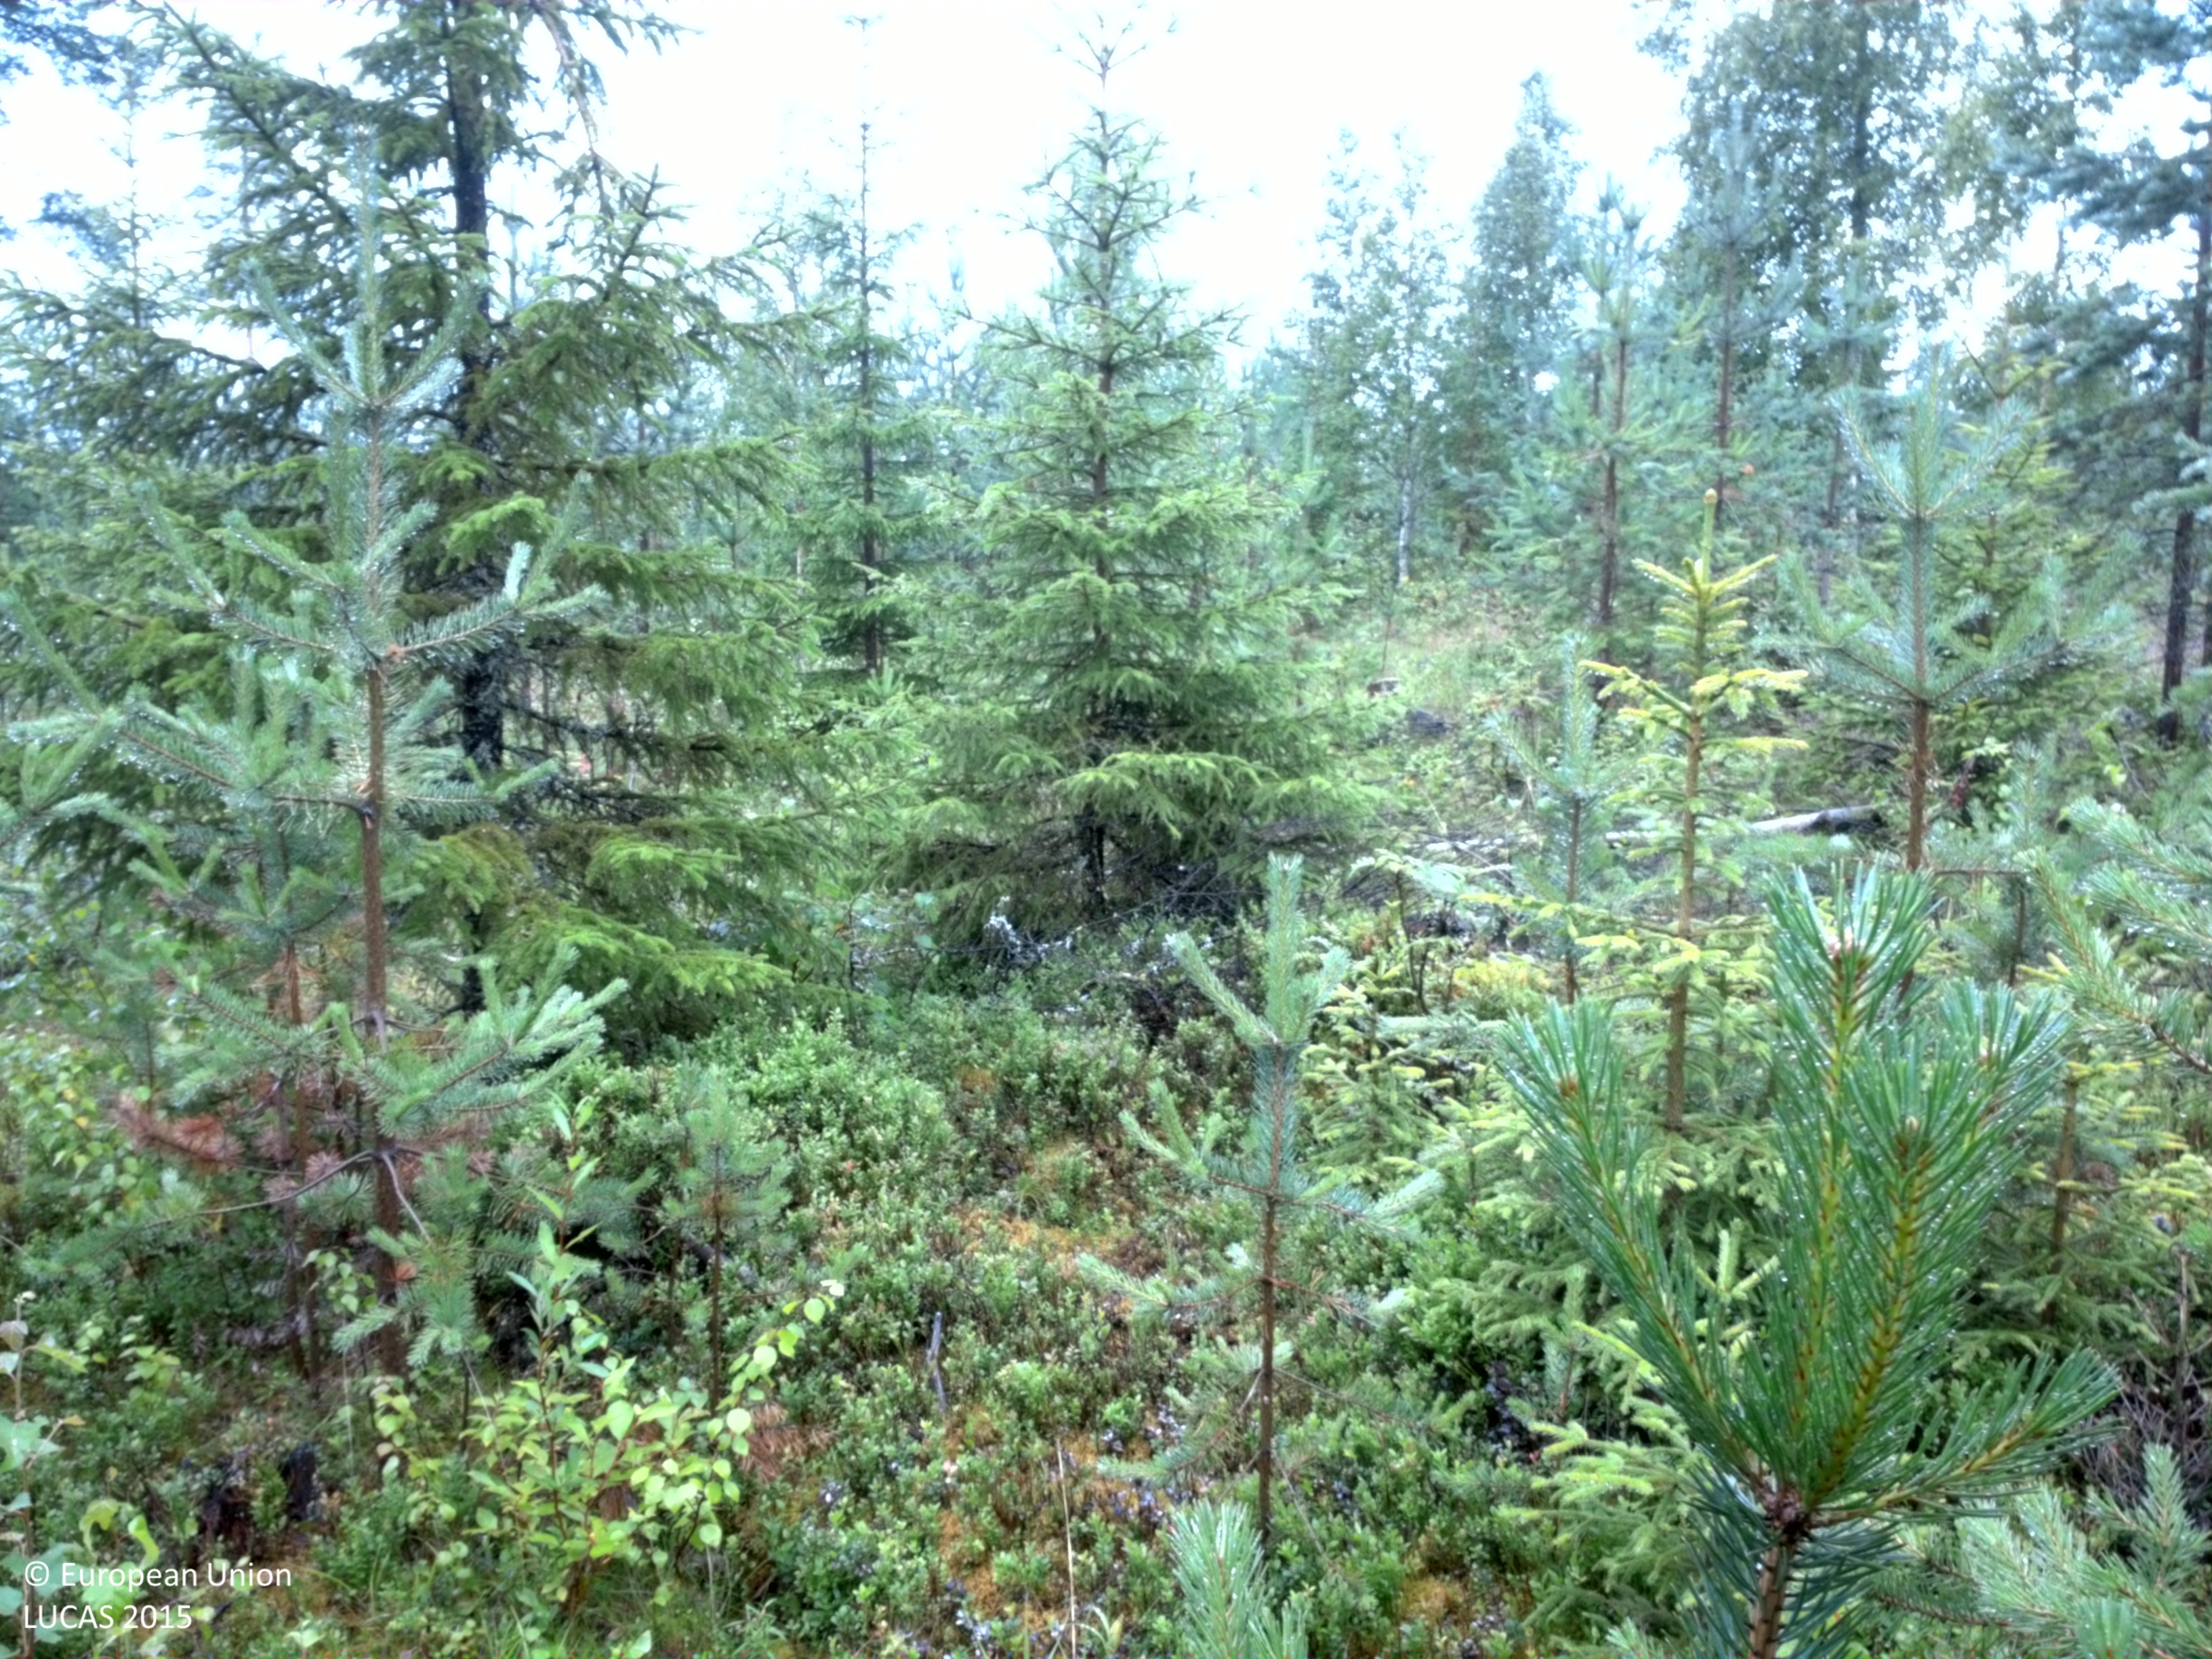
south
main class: Woodland
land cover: Pine dominated mixed woodland
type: boreal forest
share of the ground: 50 - 75 %
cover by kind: coniferous forest trees 45 %, shrubs 25 %, broadleaved forest trees 15 %, herbaceous plants 15 %
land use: Forestry
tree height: > 5 m
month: August
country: SE
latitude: 64.6947
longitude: 20.9446
